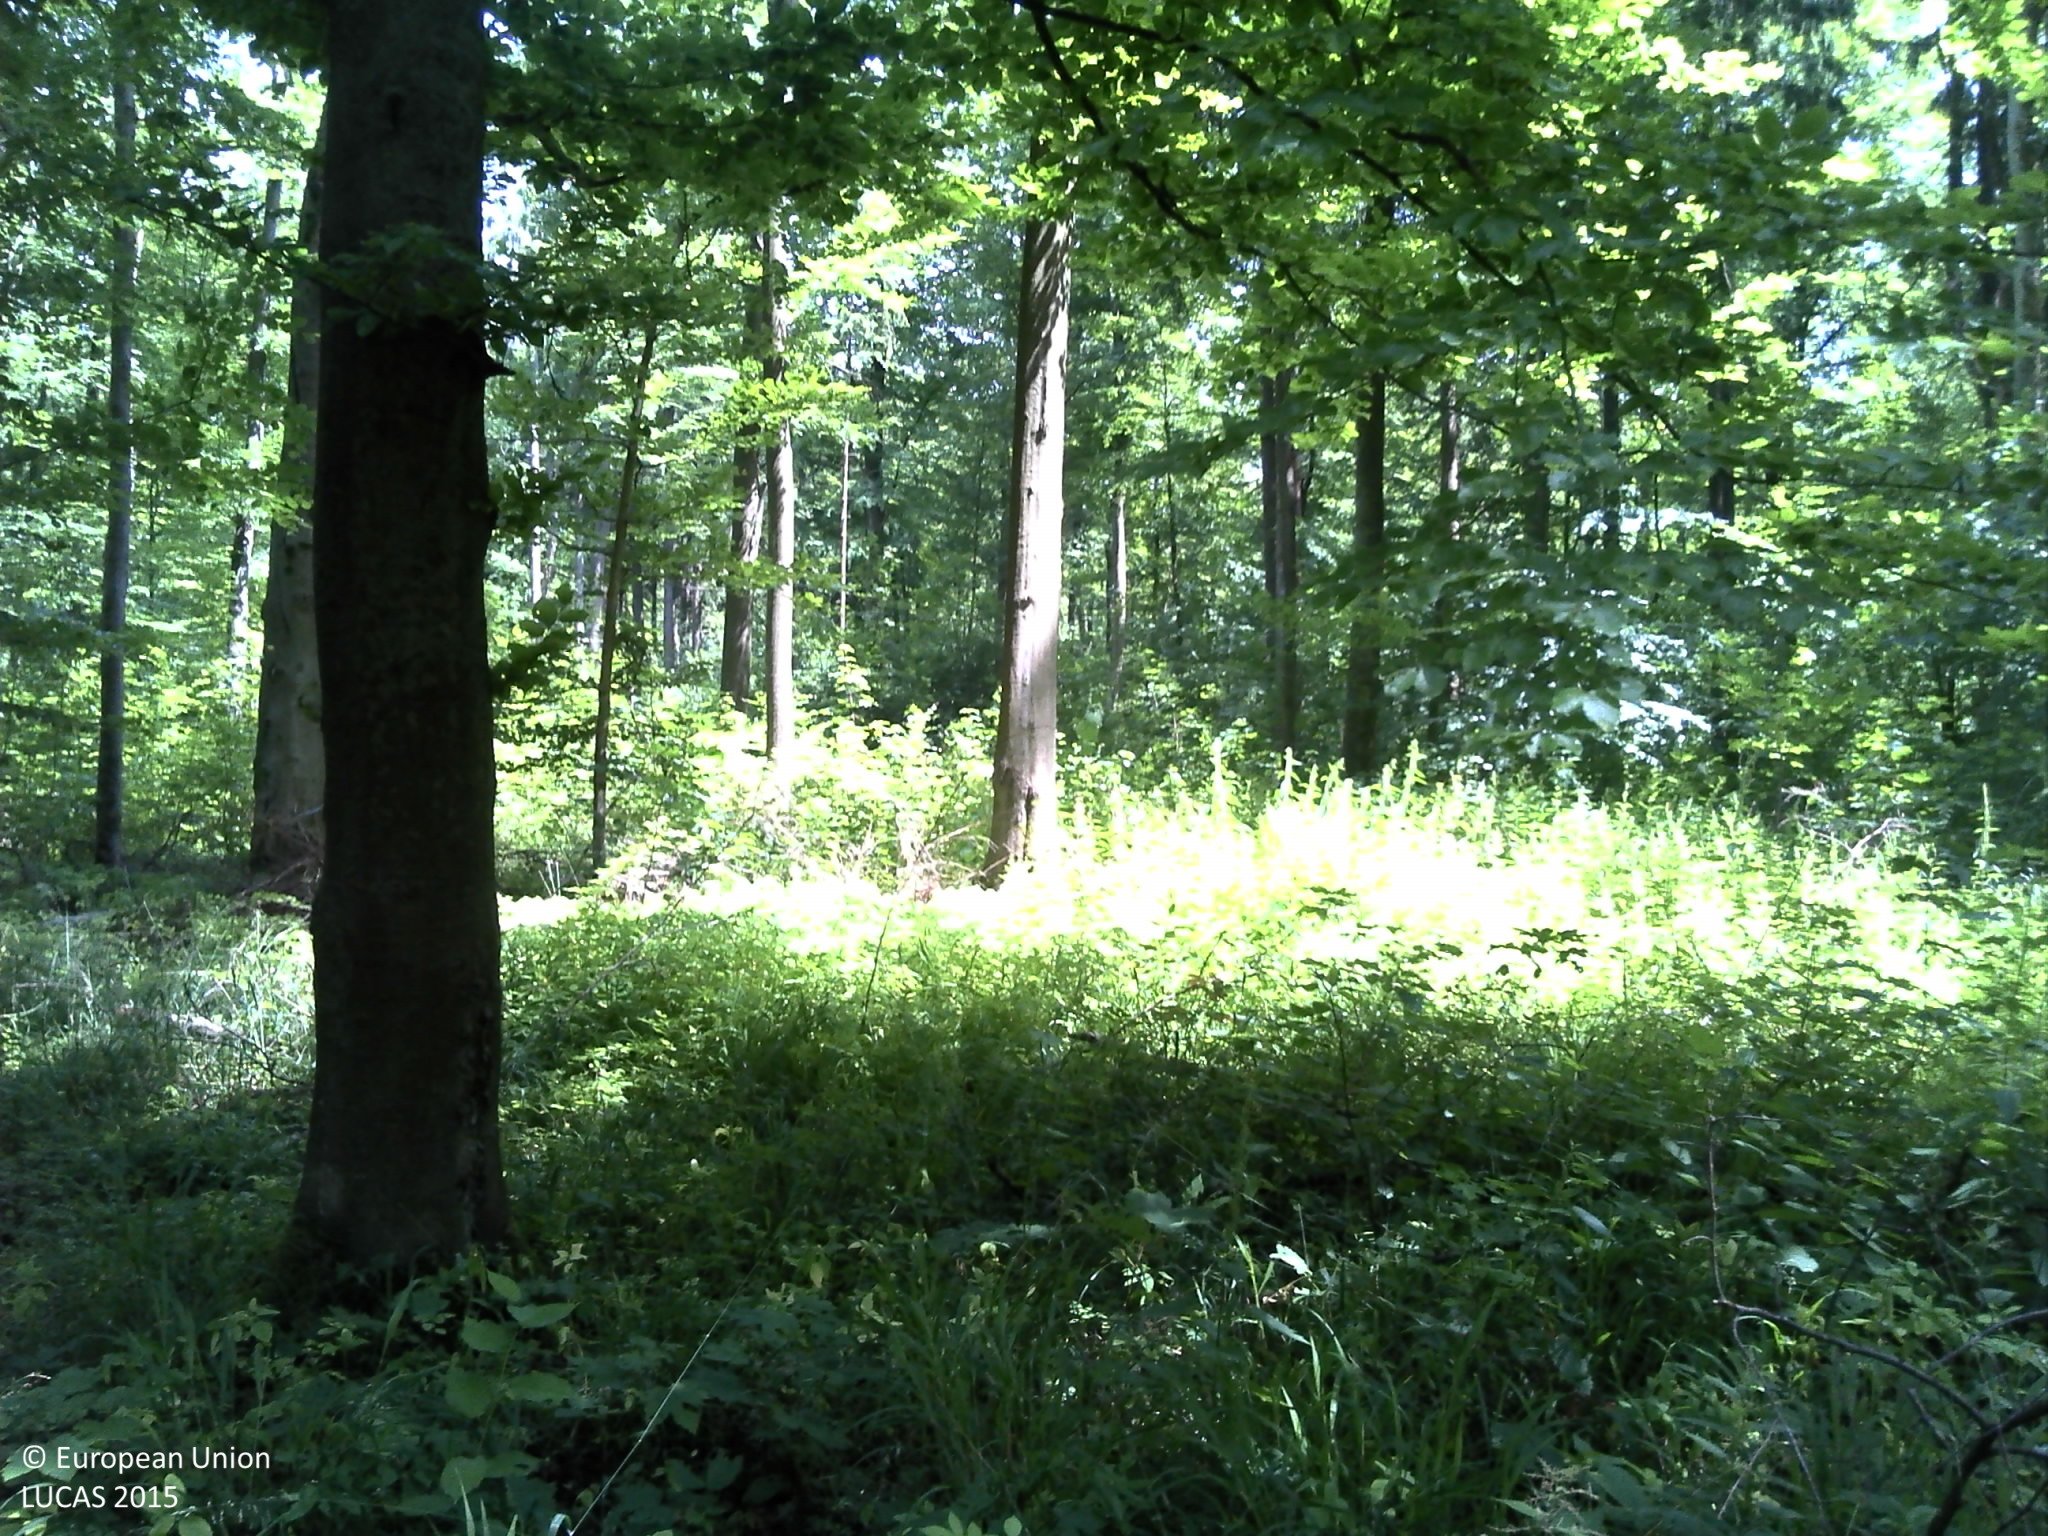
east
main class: Woodland
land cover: Broadleaved woodland
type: beech forest
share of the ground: > 75 %
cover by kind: broadleaved forest trees 80 %, coniferous forest trees 10 %, herbaceous plants 10 %
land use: Forestry
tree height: > 5 m
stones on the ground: < 10 %
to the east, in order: Broadleaved woodland; Tracks; Broadleaved woodland; Tracks; Broadleaved woodland; Tracks; Broadleaved woodland; Tracks; Broadleaved woodland
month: June
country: FR
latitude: 49.2877
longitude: 6.0537
